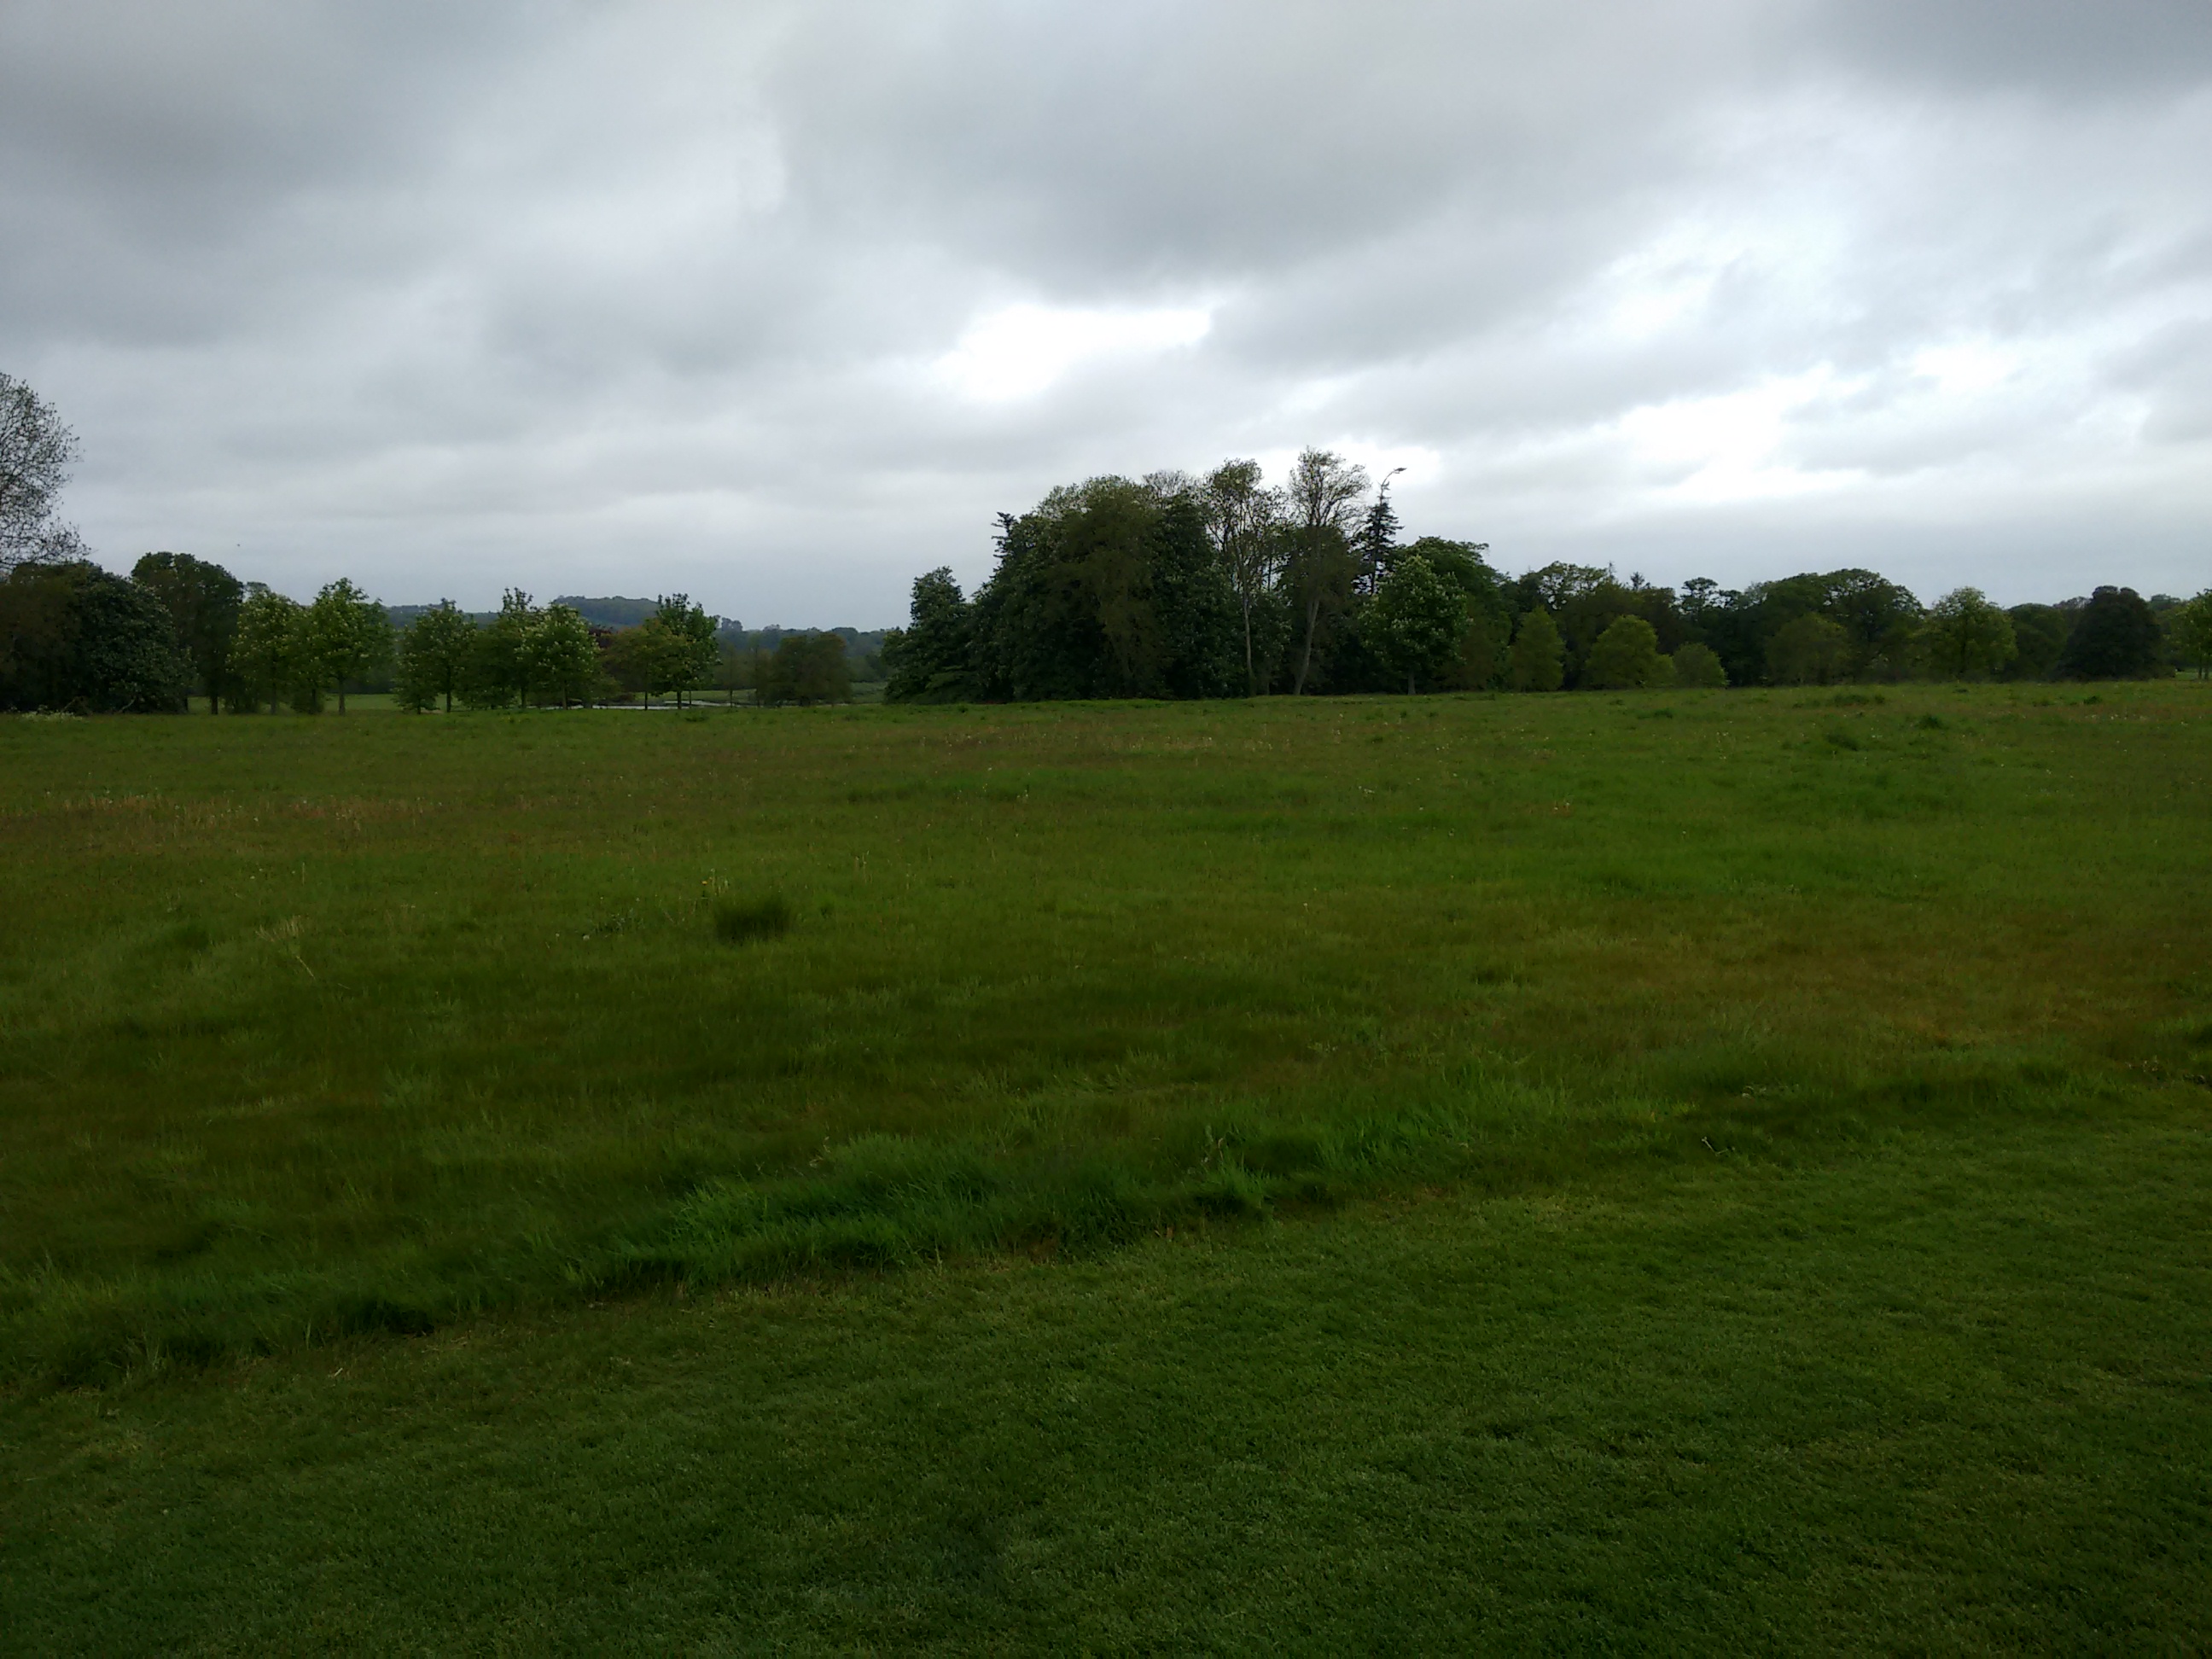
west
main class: Grassland
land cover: Grassland without tree/shrub cover
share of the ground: > 75 %
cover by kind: herbaceous plants 100 %
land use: Sport
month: May
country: IE
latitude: 53.5327
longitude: -6.5892
